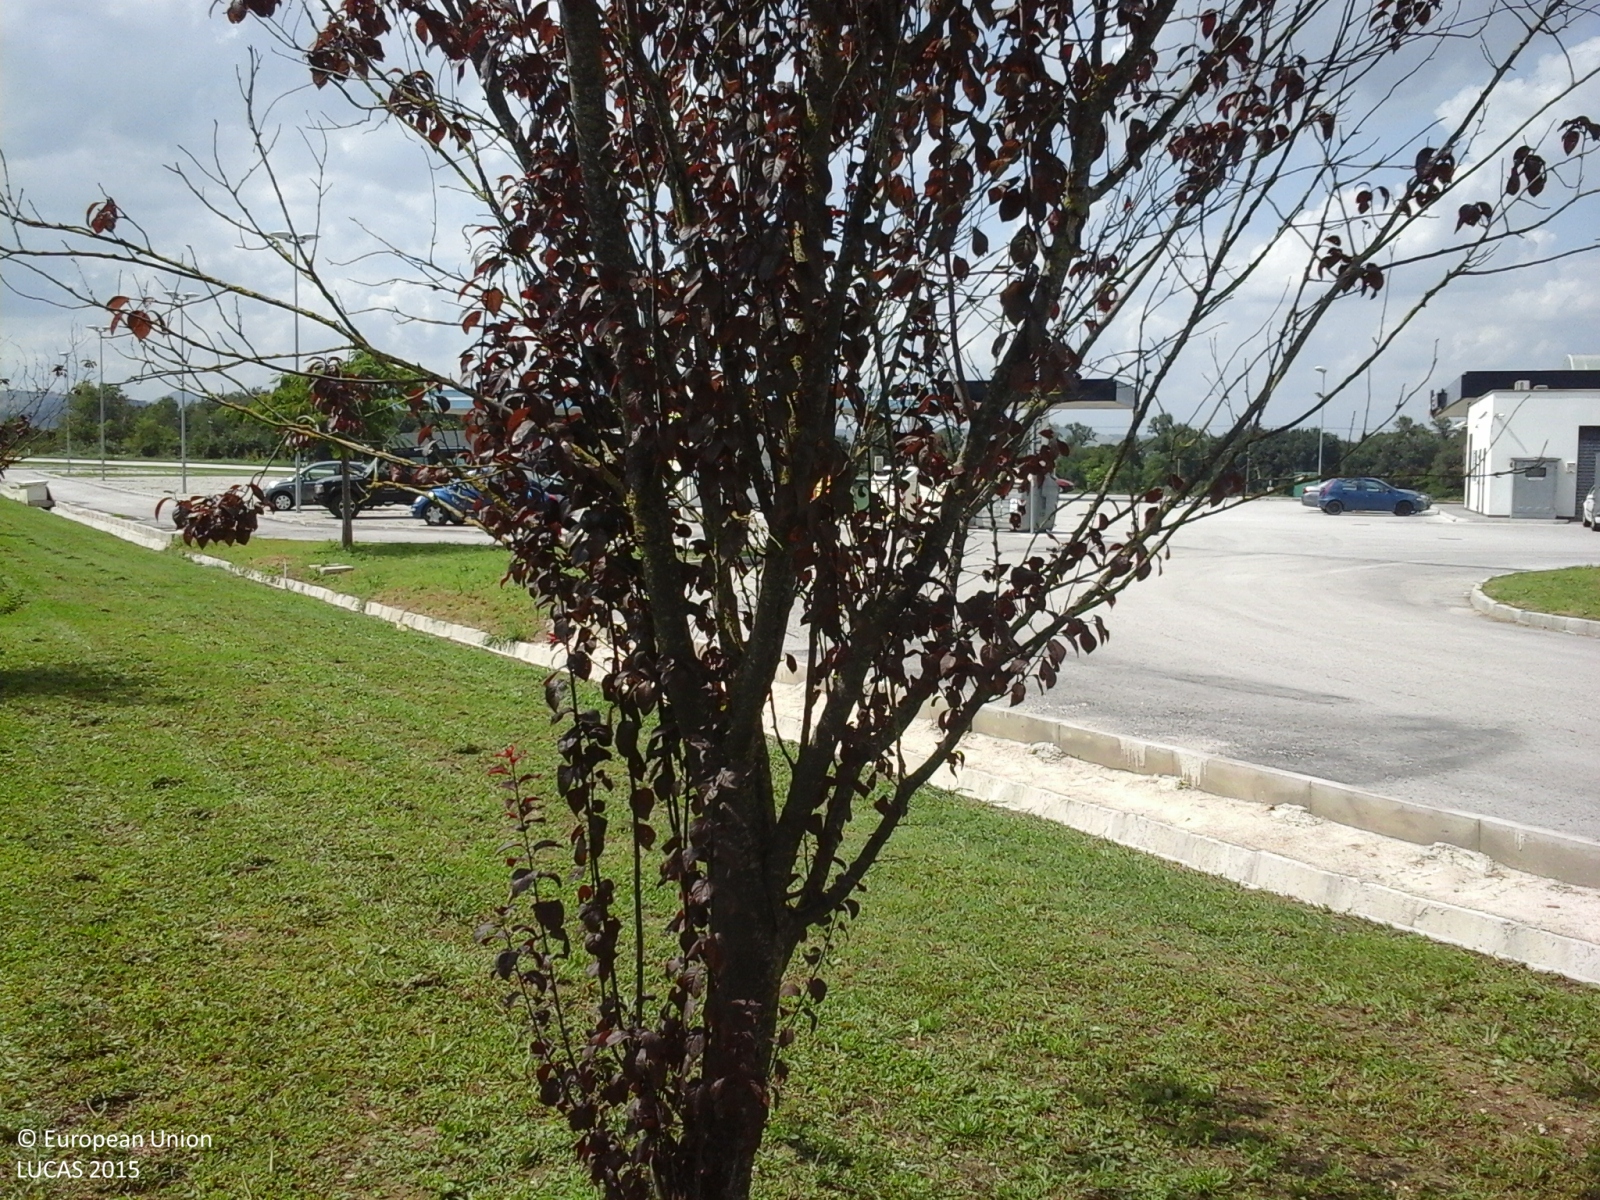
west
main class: Grassland
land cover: Grassland without tree/shrub cover
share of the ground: > 75 %
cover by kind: herbaceous plants 100 %
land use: Community services
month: August
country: IT
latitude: 43.4882
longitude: 13.2193
